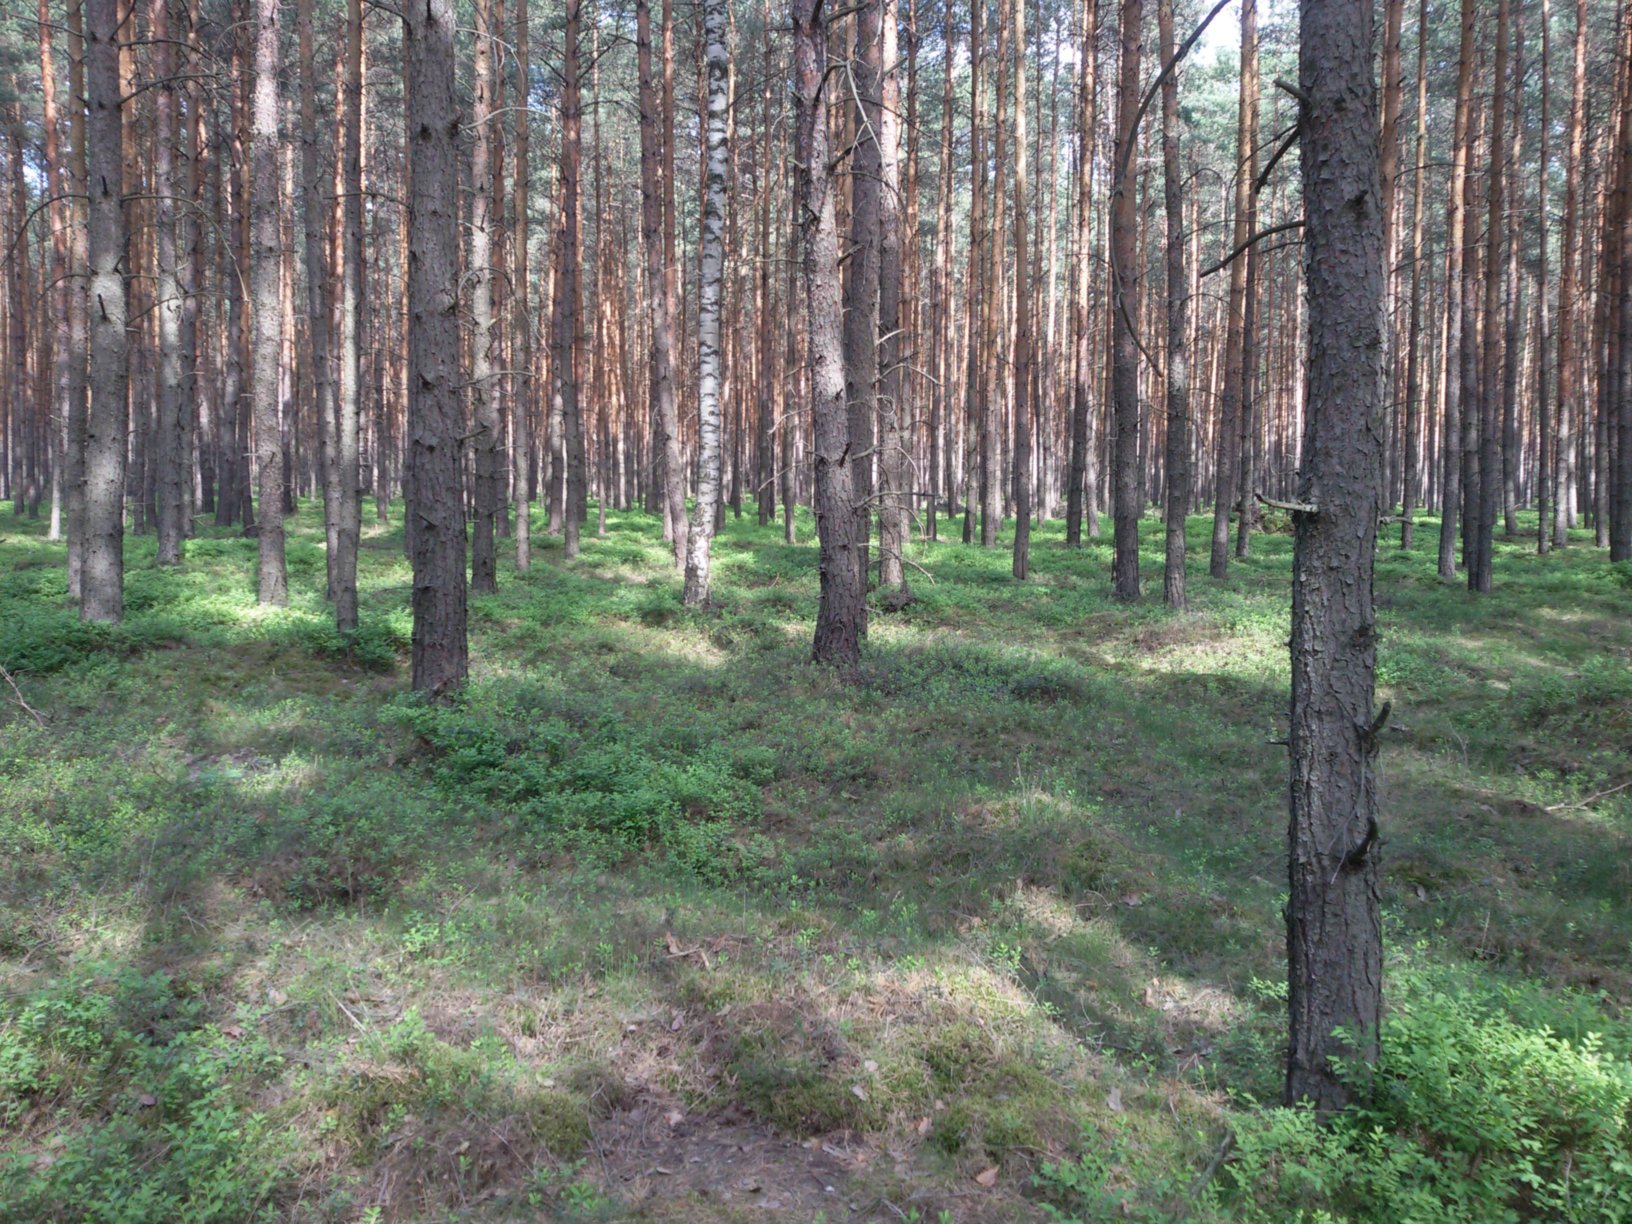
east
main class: Woodland
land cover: Pine dominated coniferous woodland
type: hemiboreal forest and nemoral coniferous forest and mixed broadleaved-coniferous forest
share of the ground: > 75 %
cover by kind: coniferous forest trees 80 %, shrubs 15 %, lichens and mosses 5 %
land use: Forestry
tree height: > 5 m
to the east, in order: Tracks; Pine dominated coniferous woodland
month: May
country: PL
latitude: 51.3682
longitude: 15.4769
